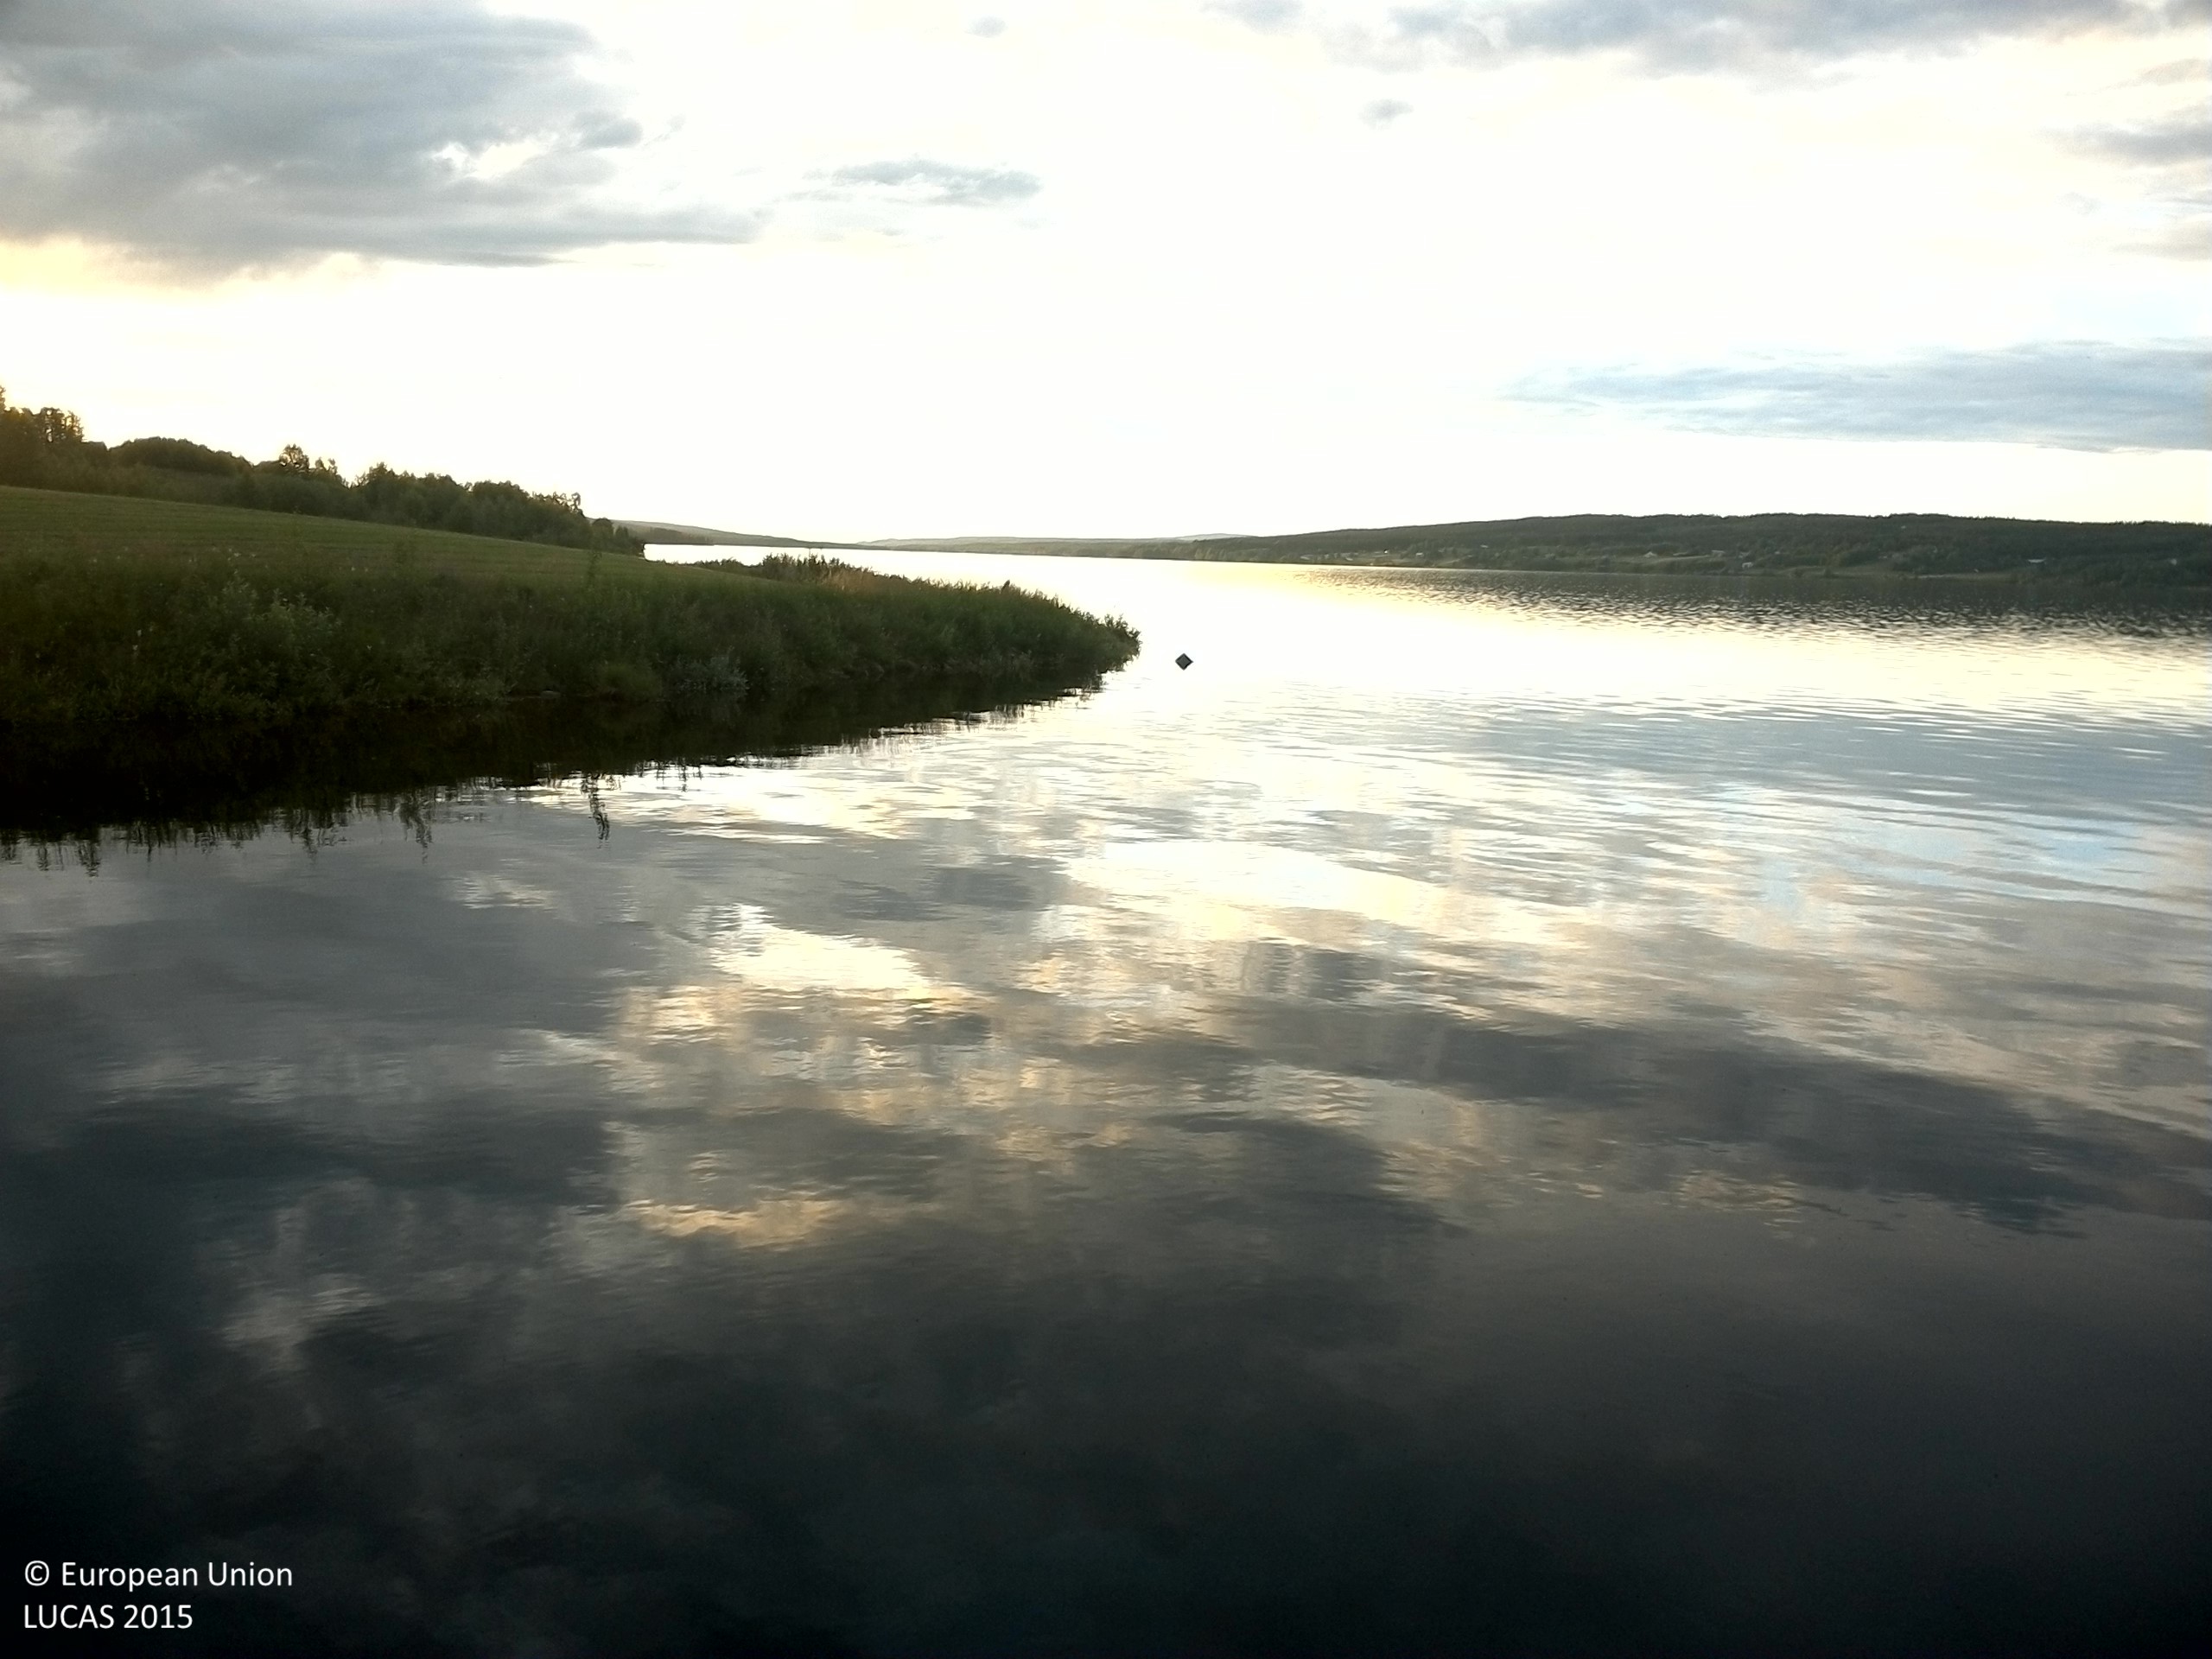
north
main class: Grassland
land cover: Grassland without tree/shrub cover
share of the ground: > 75 %
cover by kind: herbaceous plants 100 %
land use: Residential
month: July
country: SE
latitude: 64.3932
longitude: 16.0040
